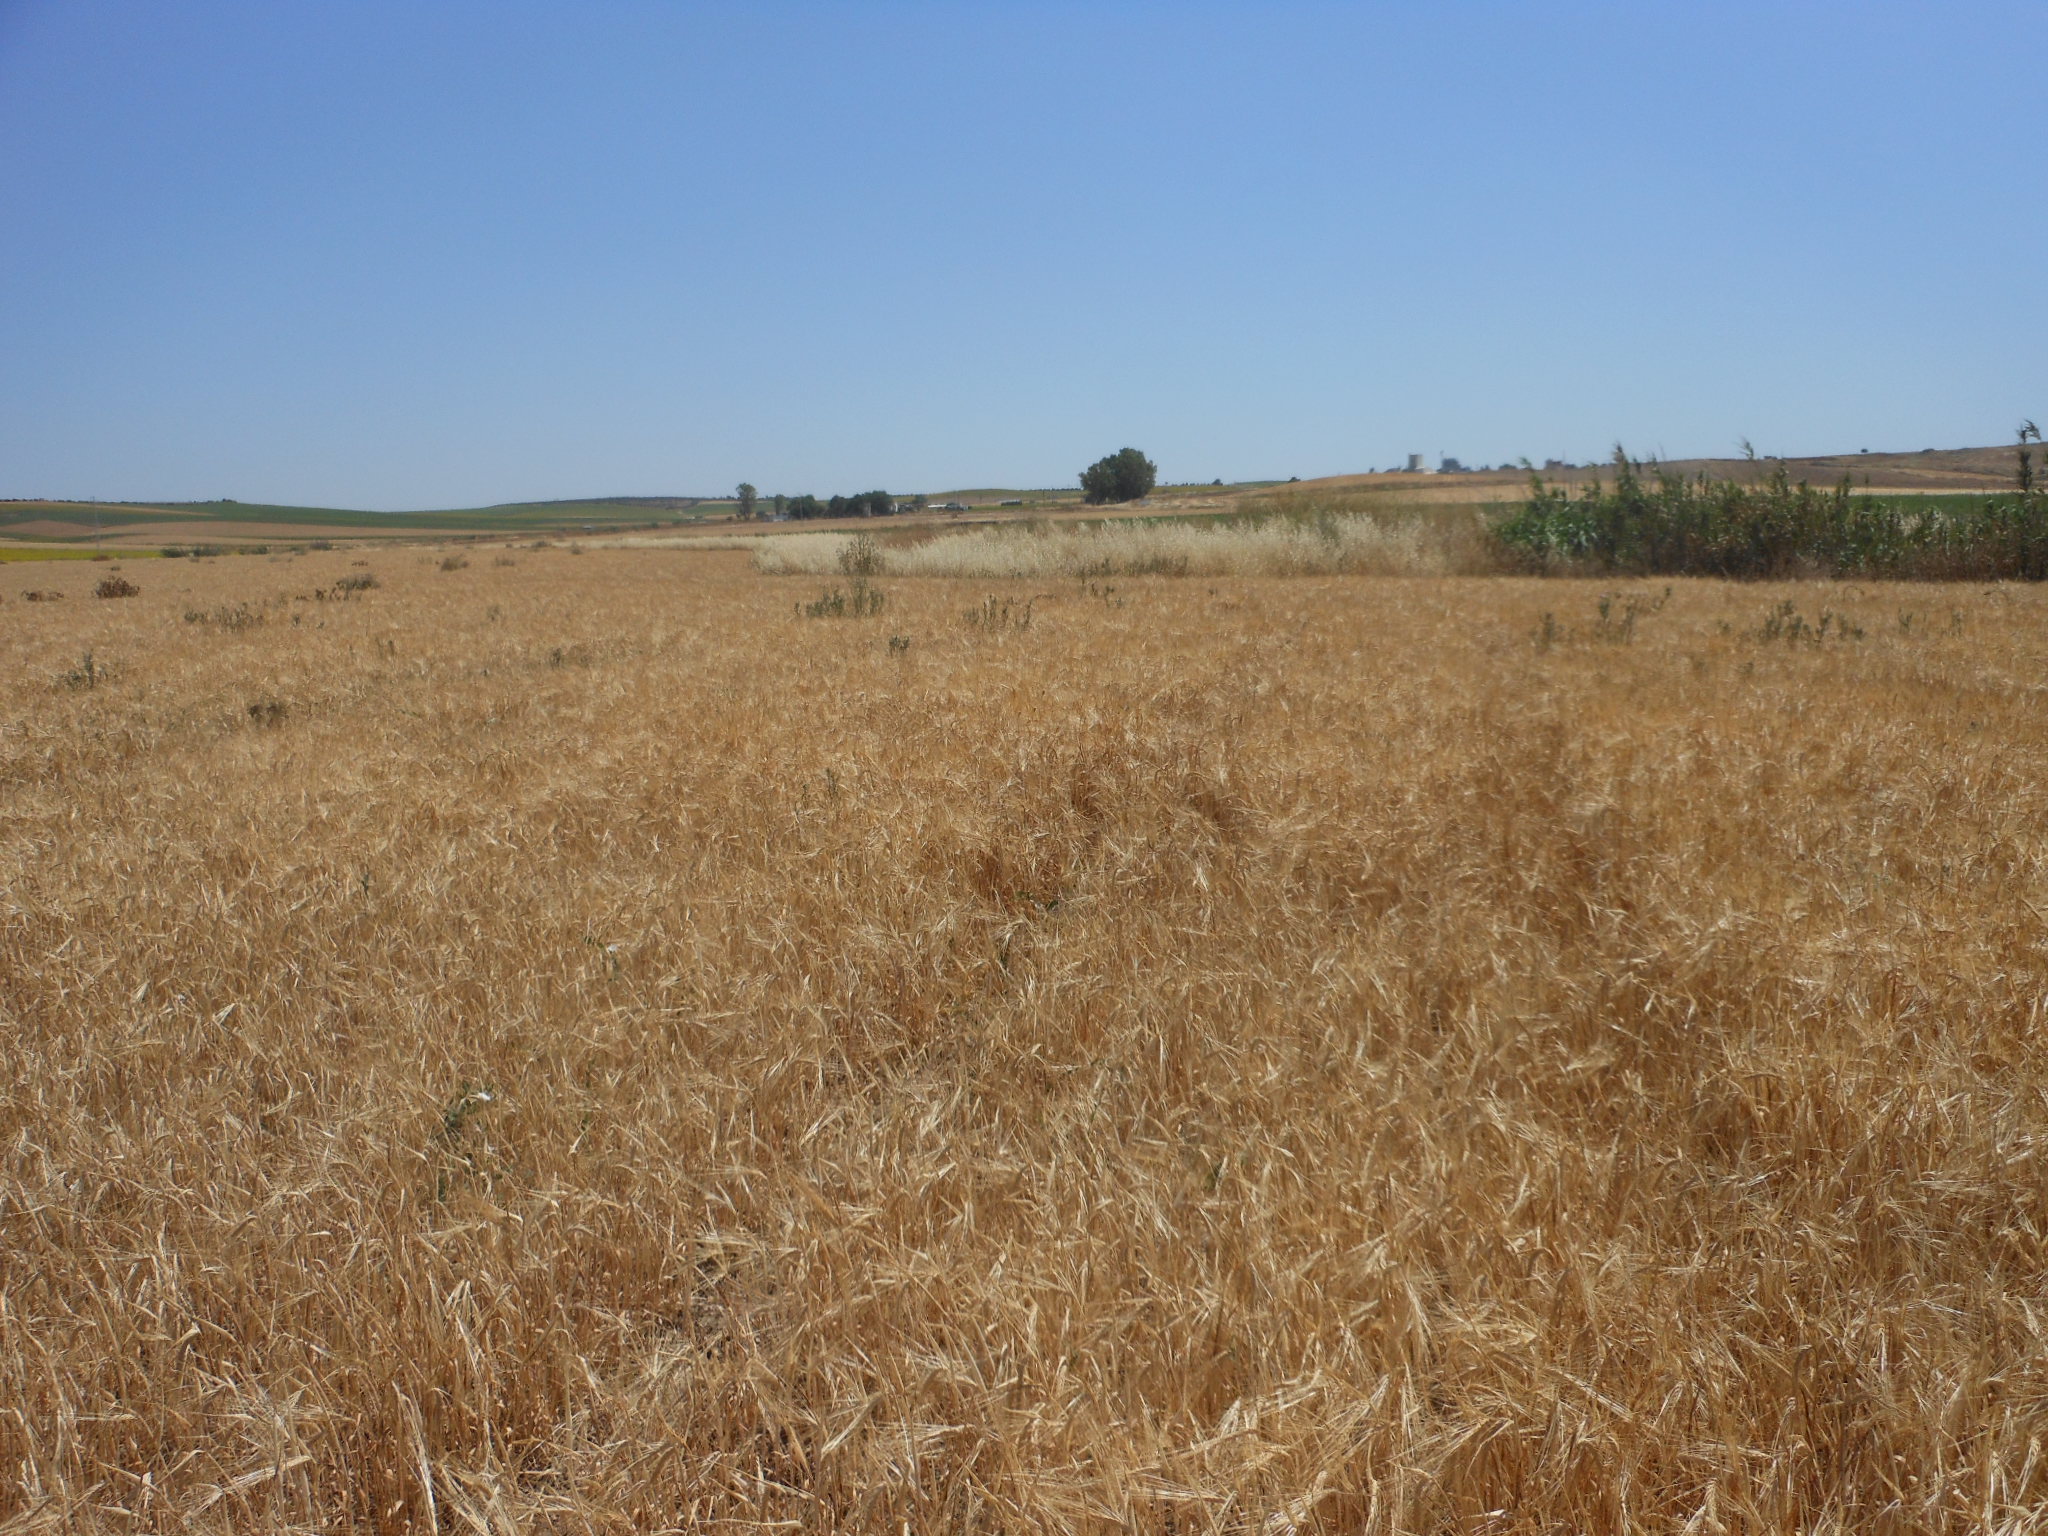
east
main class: Cropland
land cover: Barley
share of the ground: > 75 %
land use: Agriculture (excluding fallow land and kitchen gardens)
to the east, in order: Barley; Grass margins; Rivers and streams; Grassland with sparse tree/shrub cover; Sunflower
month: May
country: ES
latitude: 37.4606
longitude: -5.4027
